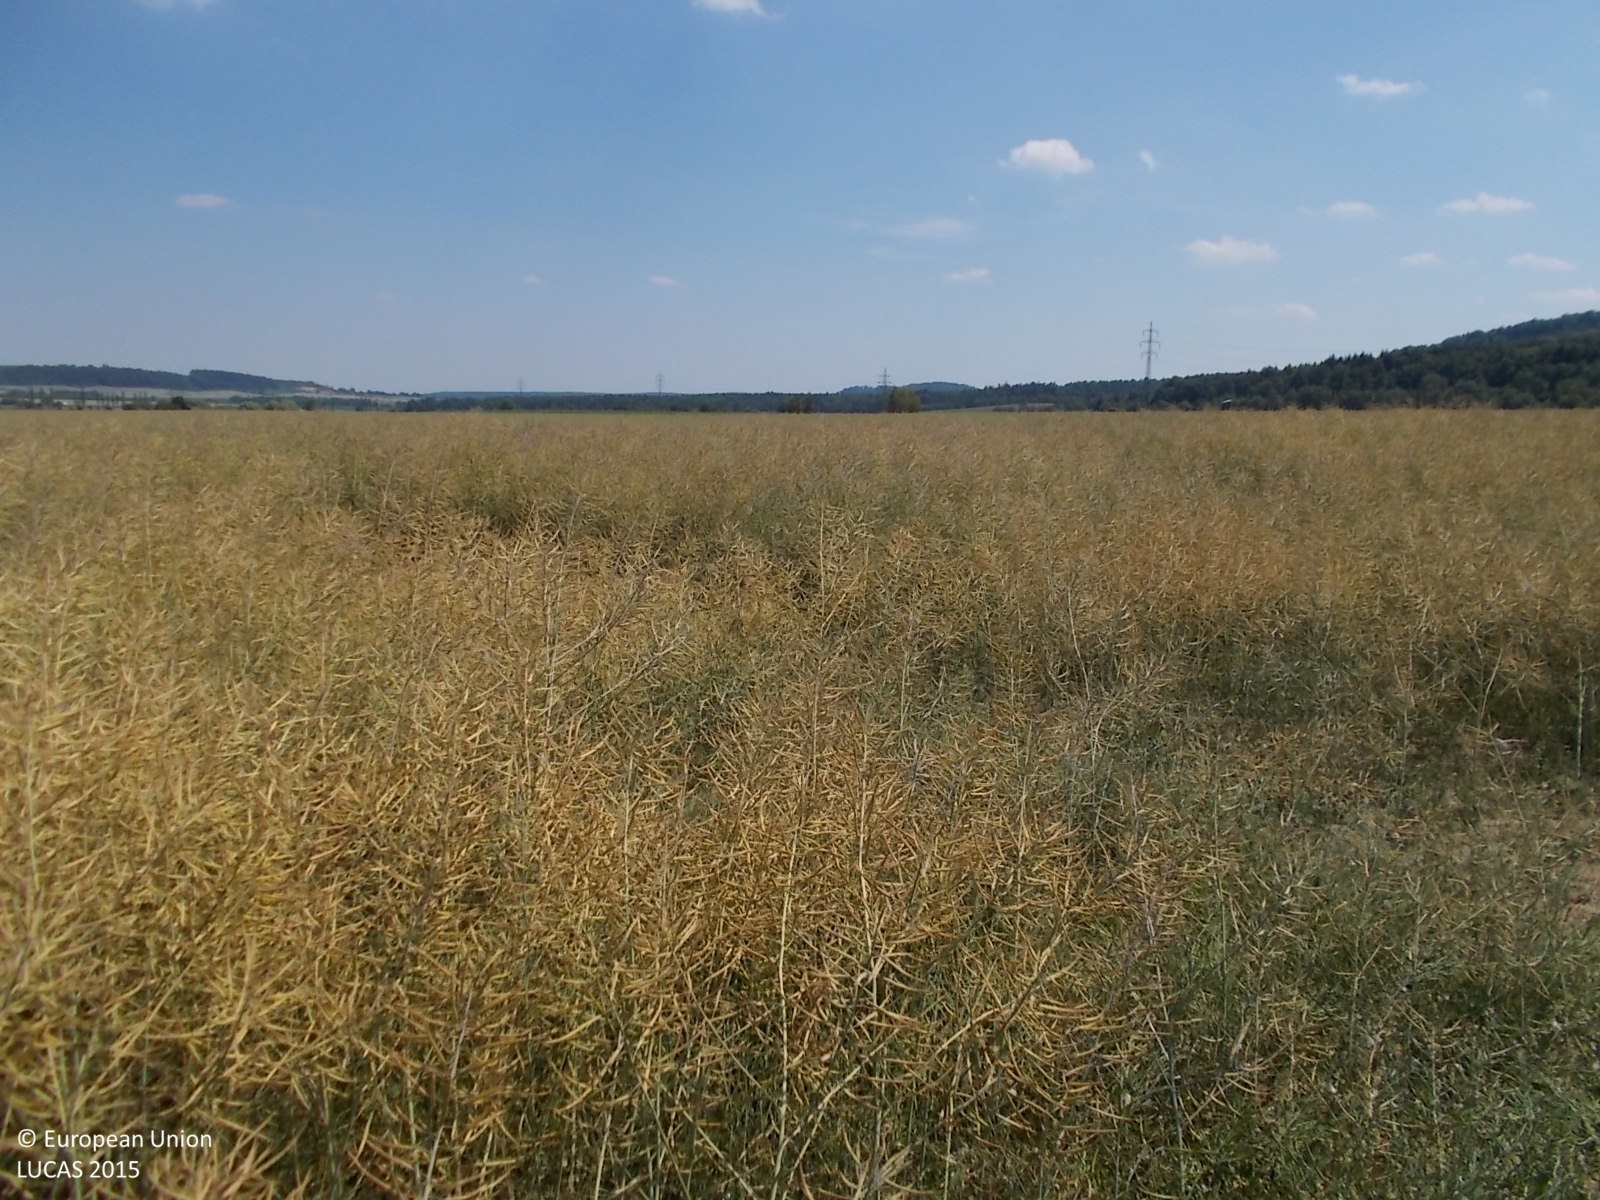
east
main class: Cropland
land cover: Rape and turnip rape
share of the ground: > 75 %
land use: Agriculture (excluding fallow land and kitchen gardens)
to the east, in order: Rape and turnip rape; Tracks; Maize
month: July
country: CZ
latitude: 50.1751
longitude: 13.7953
